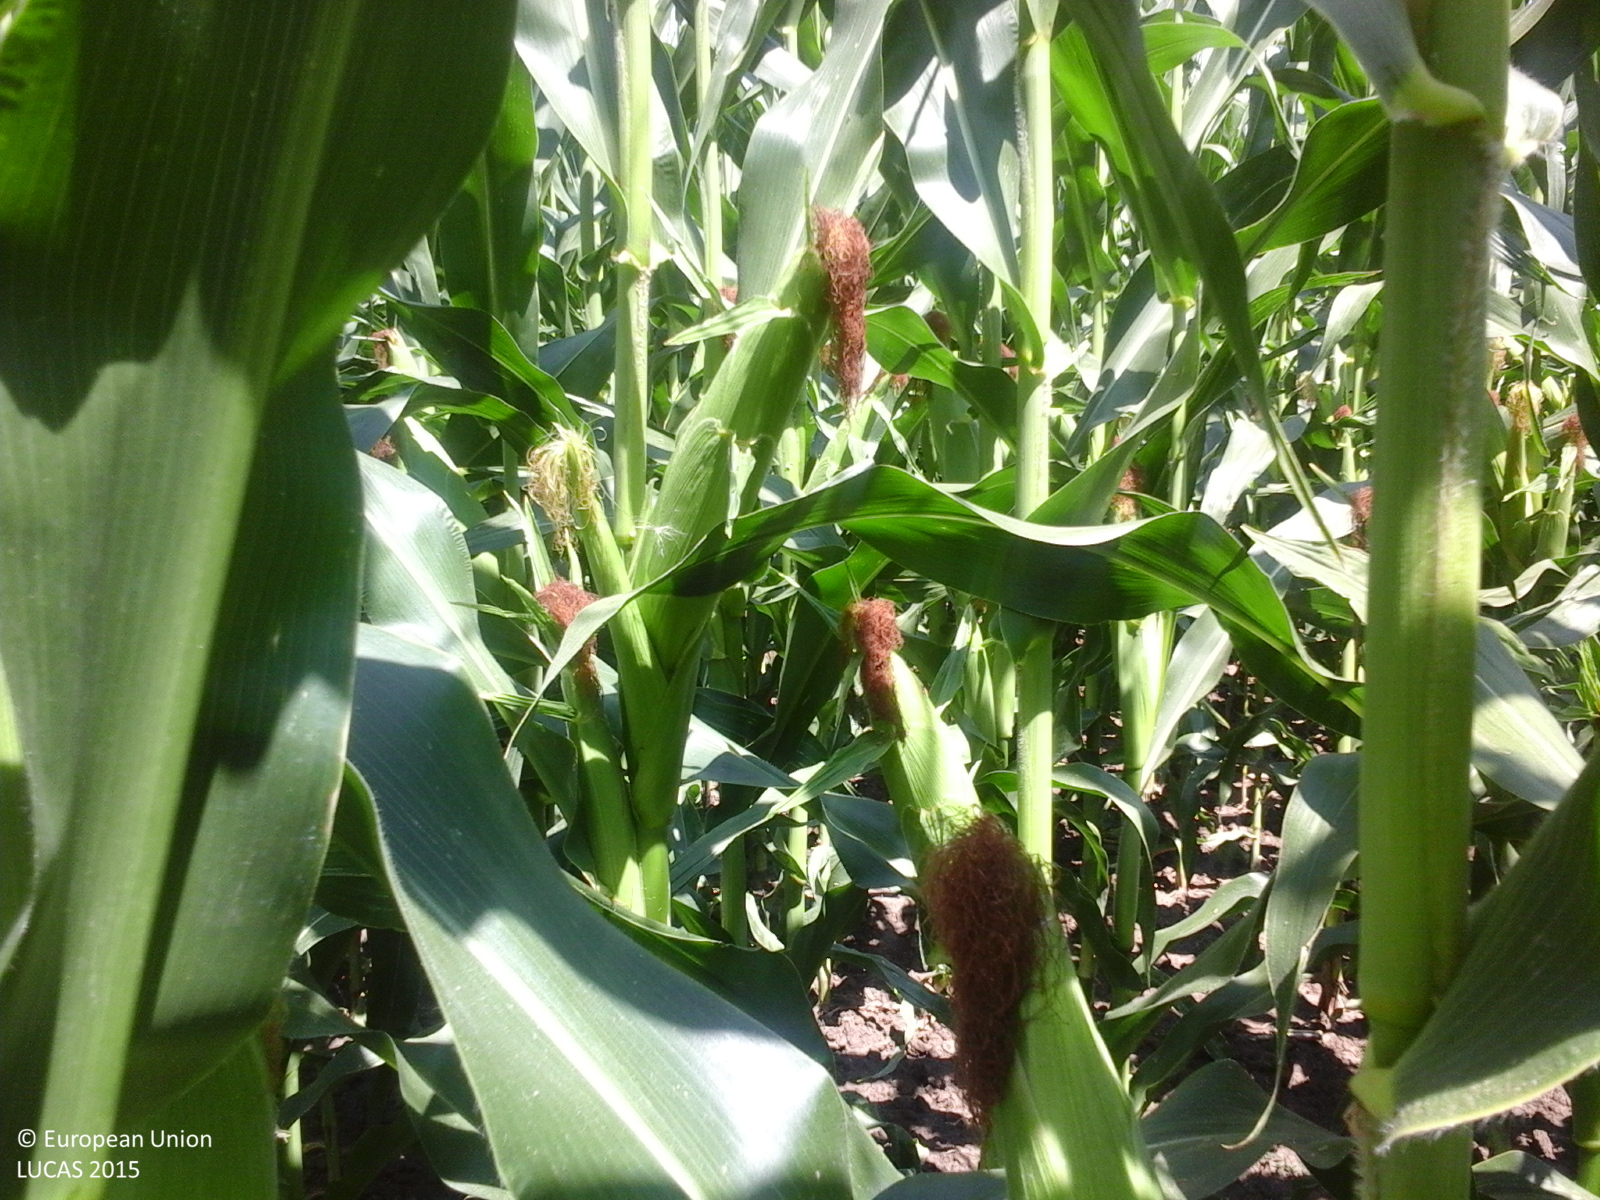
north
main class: Cropland
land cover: Maize
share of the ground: > 75 %
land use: Agriculture (excluding fallow land and kitchen gardens)
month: July
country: RO
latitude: 44.5188
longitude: 27.1037
